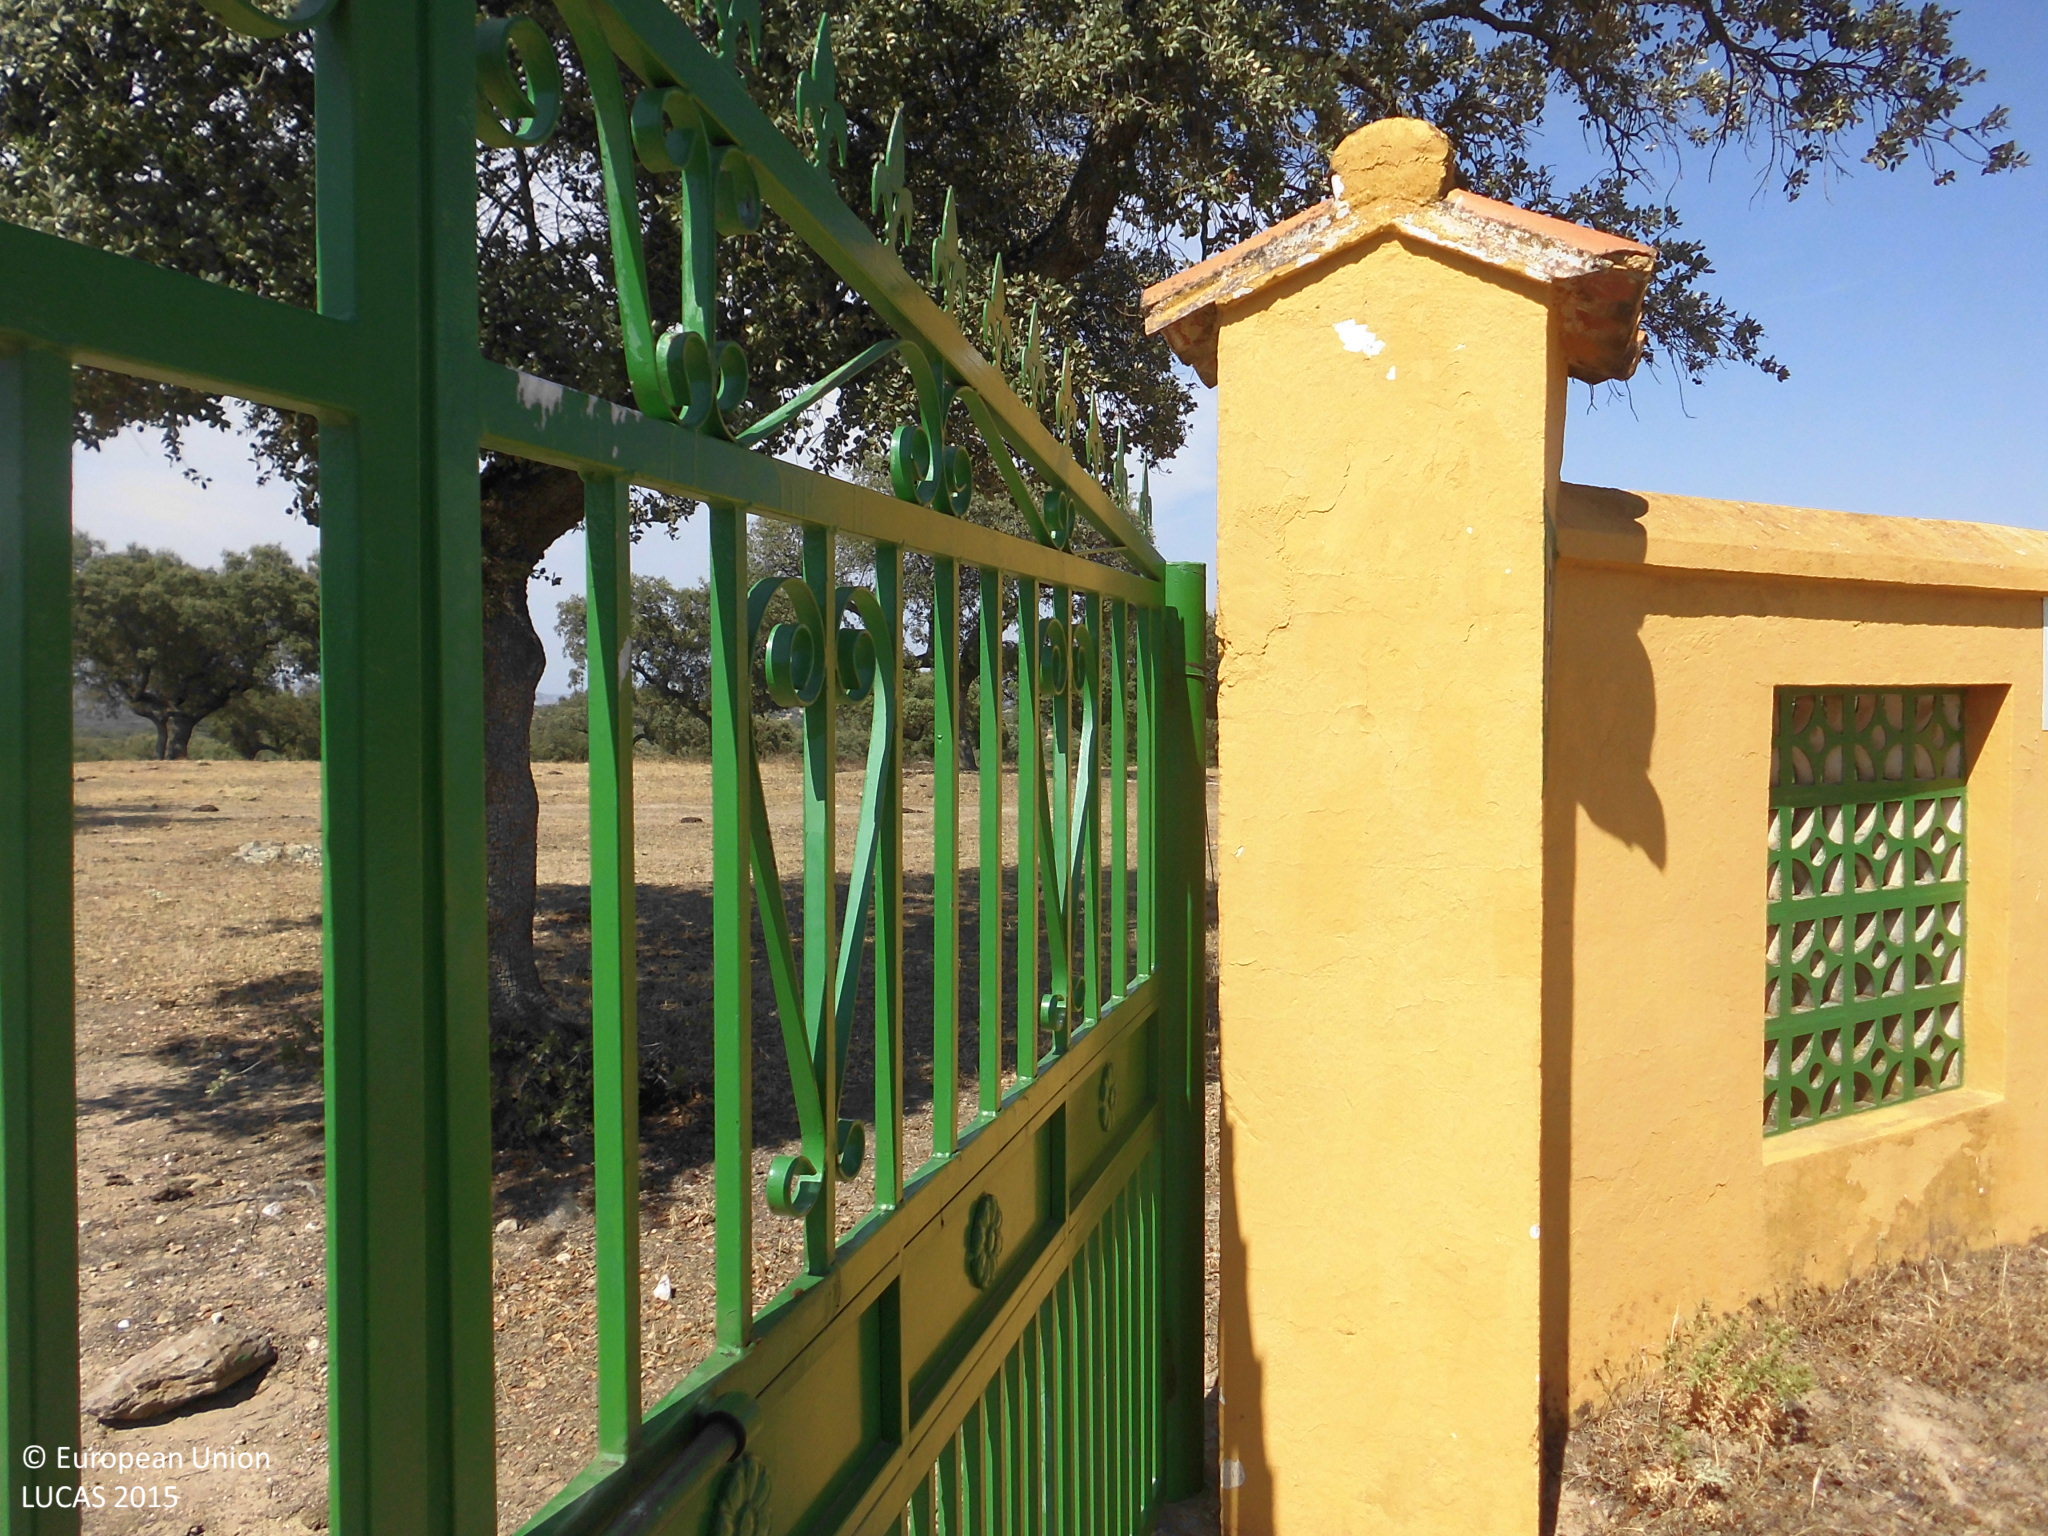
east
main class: Woodland
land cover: Broadleaved woodland
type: broadleaved evergreen forest
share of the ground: 25 - 50 %
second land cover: Grassland without tree/shrub cover
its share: > 75 %
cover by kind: herbaceous plants 60 %, broadleaved forest trees 40 %
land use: Forestry
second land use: Agriculture (excluding fallow land and kitchen gardens)
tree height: > 5 m
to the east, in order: Broadleaved woodland; Grassland without tree/shrub cover; Broadleaved woodland; Rivers and streams; Broadleaved woodland
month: June
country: ES
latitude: 39.7635
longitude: -6.1659
